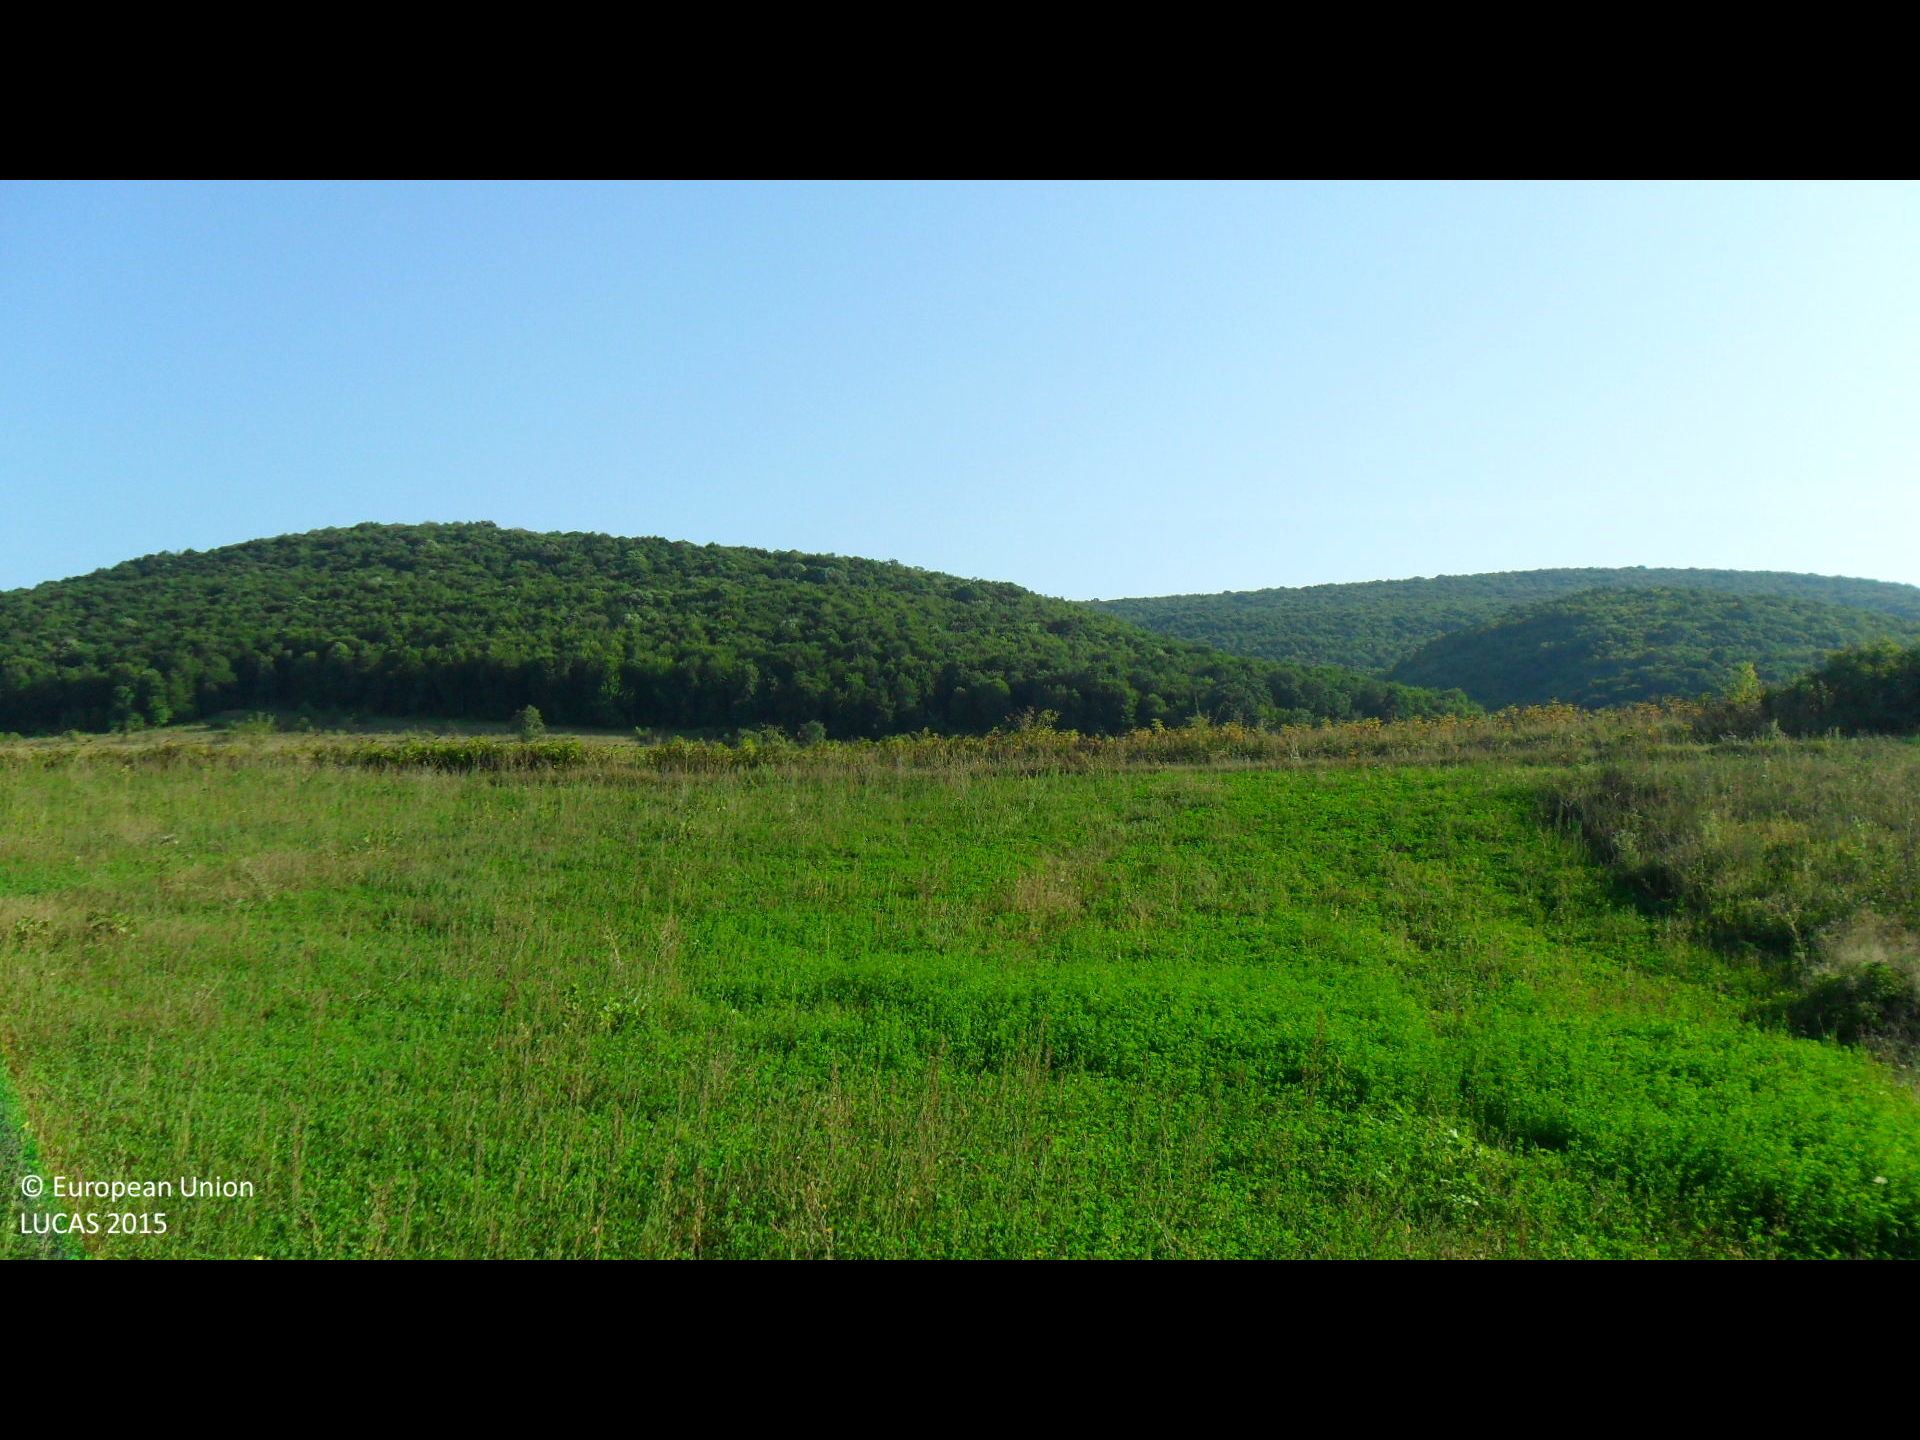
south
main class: Woodland
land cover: Broadleaved woodland
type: mesophytic deciduous forest
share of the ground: > 75 %
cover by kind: broadleaved forest trees 100 %
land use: Forestry
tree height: > 5 m
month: August
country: BG
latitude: 43.1816
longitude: 26.6269
